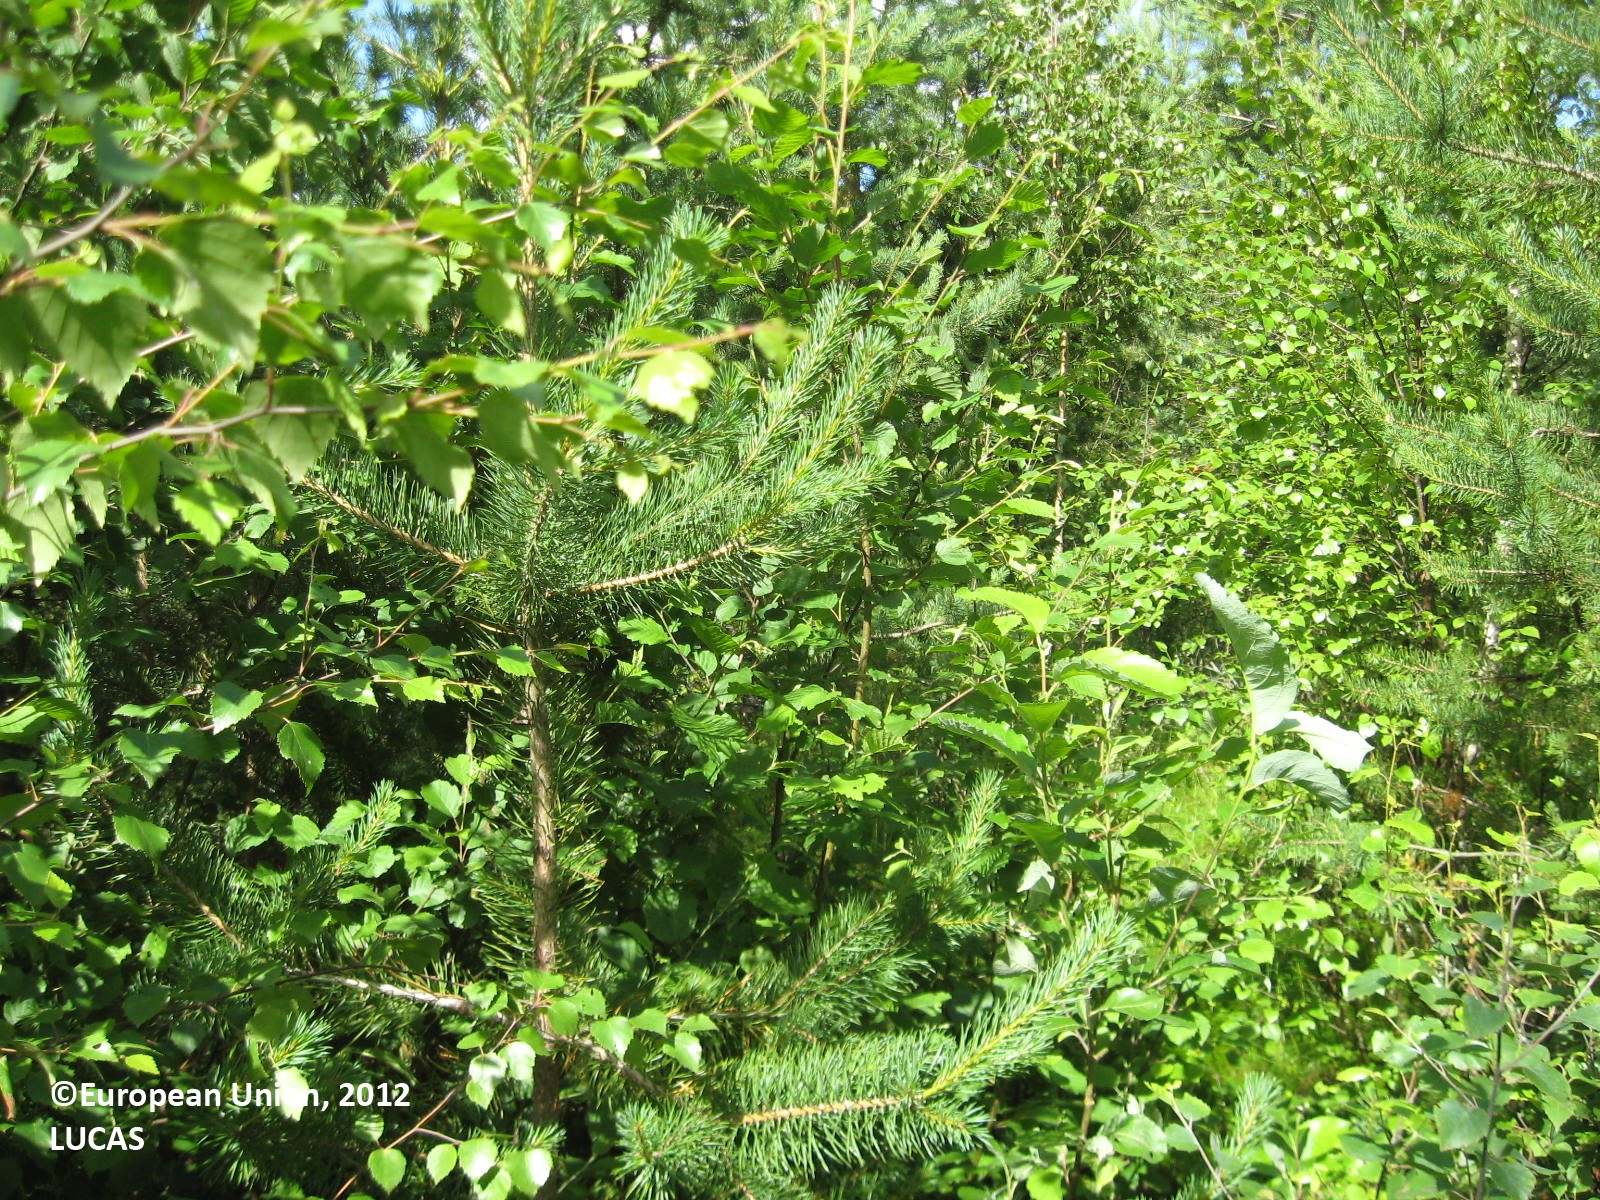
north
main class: Woodland
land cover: Other mixed woodland
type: boreal forest
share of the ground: > 75 %
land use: Forestry
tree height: > 5 m
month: July
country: FI
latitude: 62.2506
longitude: 22.3188
